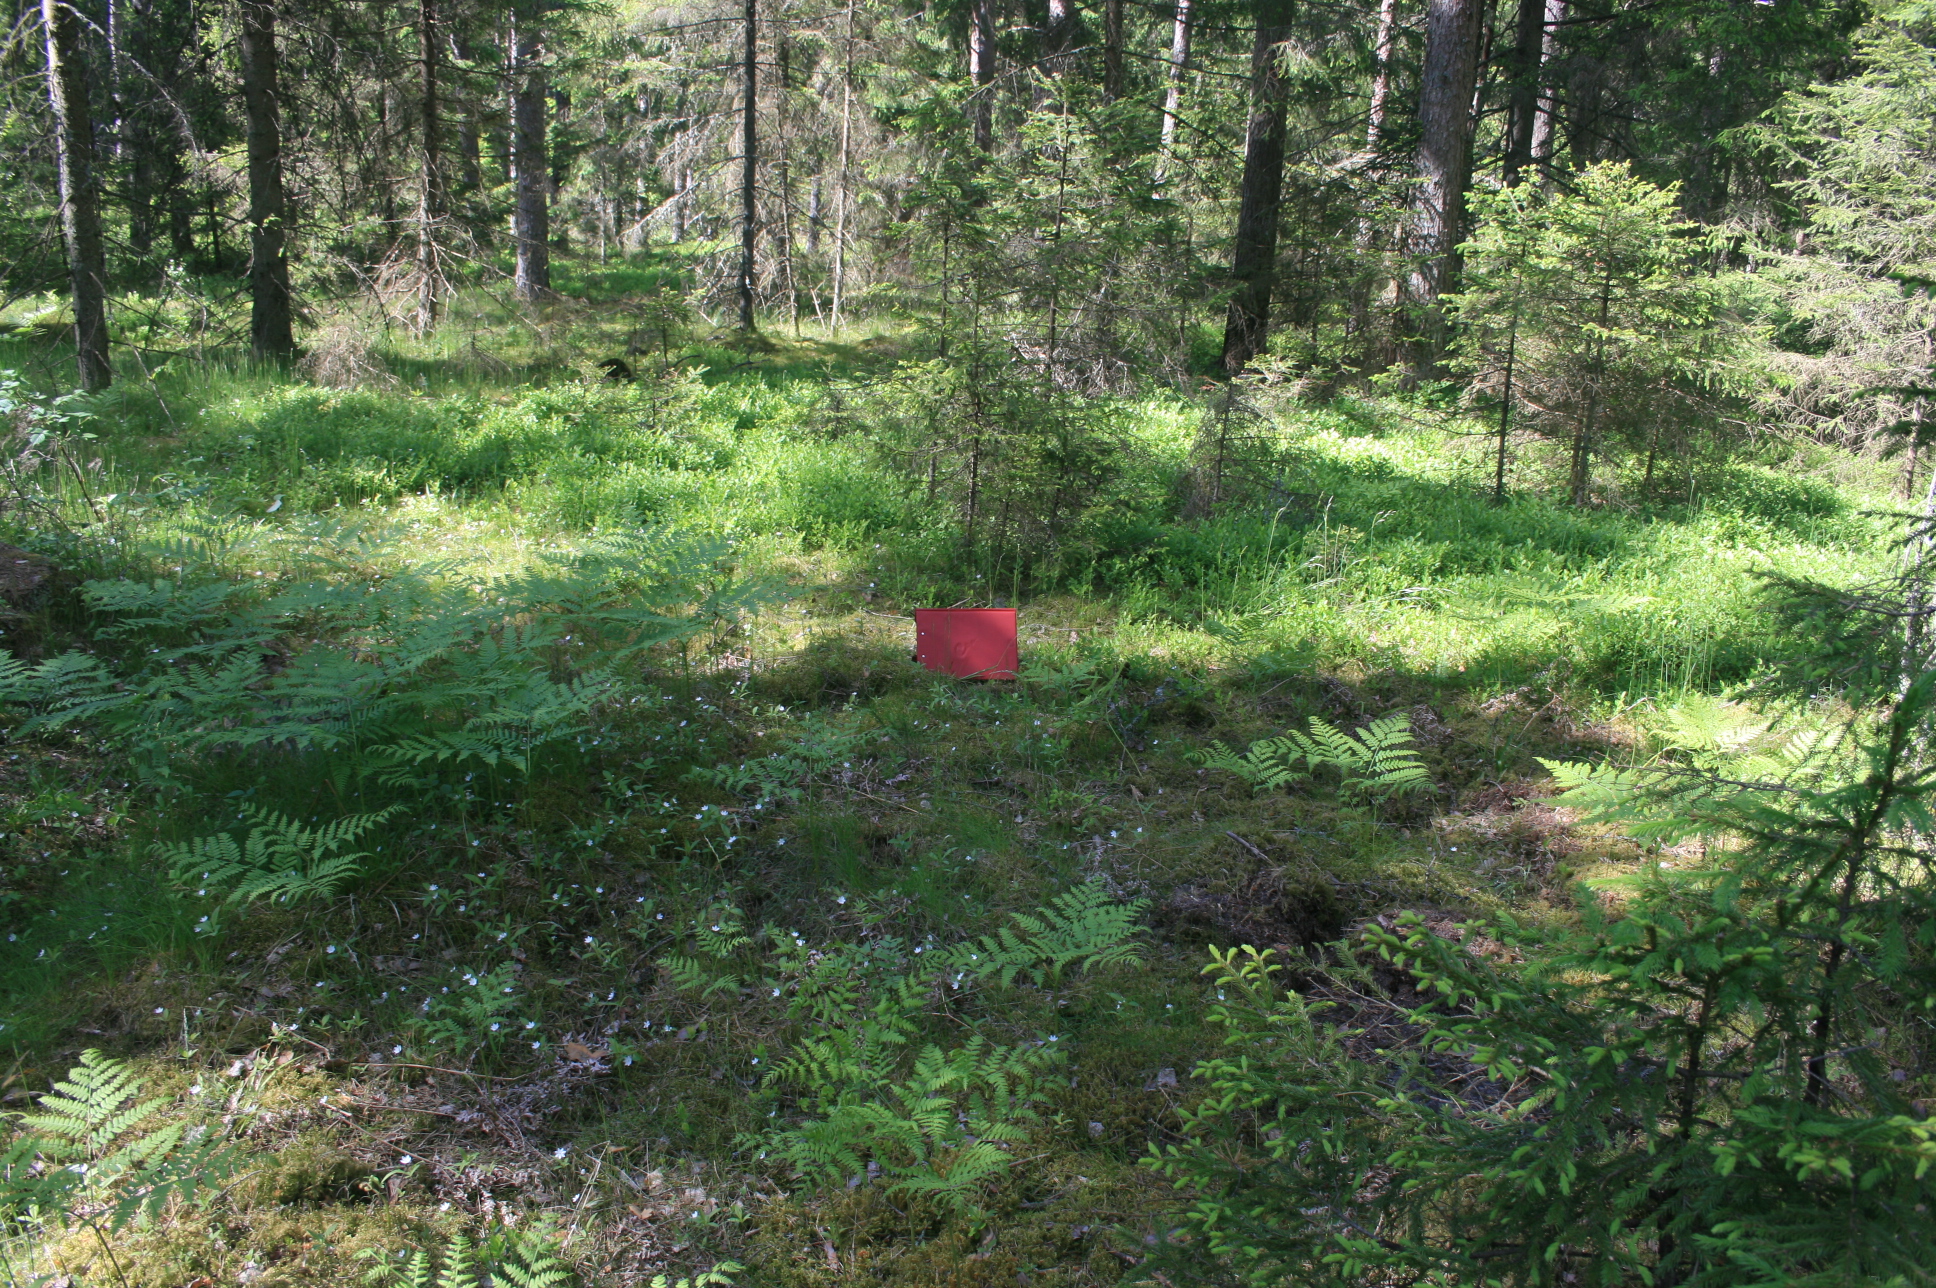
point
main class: Woodland
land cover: Spruce dominated coniferous woodland
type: hemiboreal forest and nemoral coniferous forest and mixed broadleaved-coniferous forest
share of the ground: > 75 %
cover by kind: coniferous forest trees 85 %, broadleaved forest trees 10 %, herbaceous plants 5 %
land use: Forestry
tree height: > 5 m
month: June
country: LT
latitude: 55.7976
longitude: 22.2588
